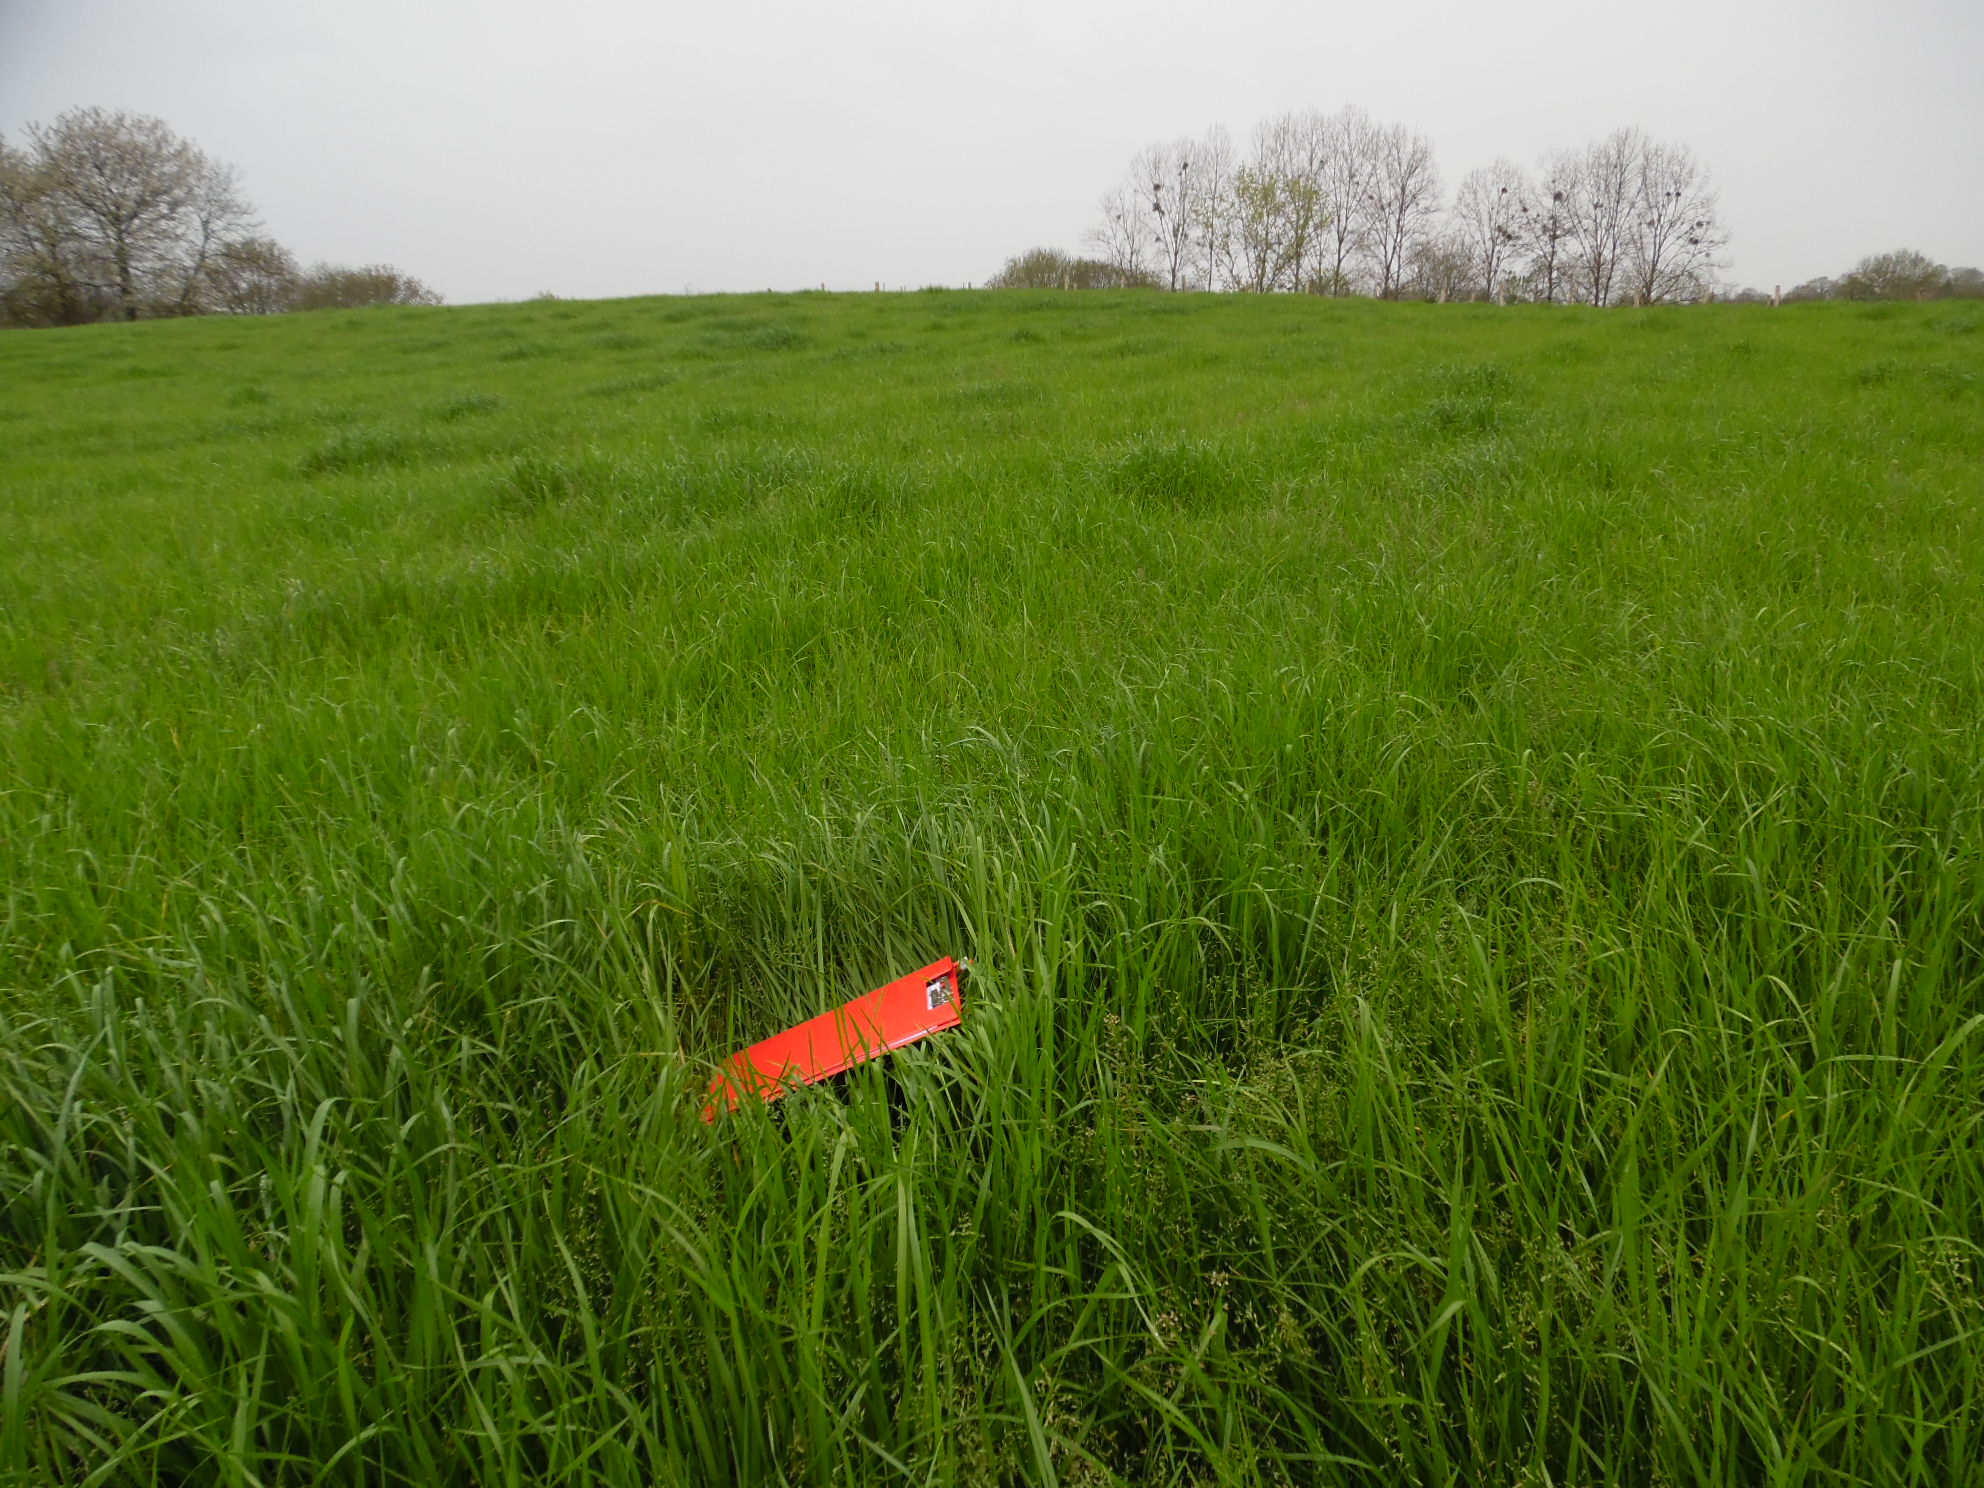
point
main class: Cropland
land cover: Temporary grasslands
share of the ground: > 75 %
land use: Agriculture (excluding fallow land and kitchen gardens)
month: April
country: ES
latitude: 43.3621
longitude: -5.4918
